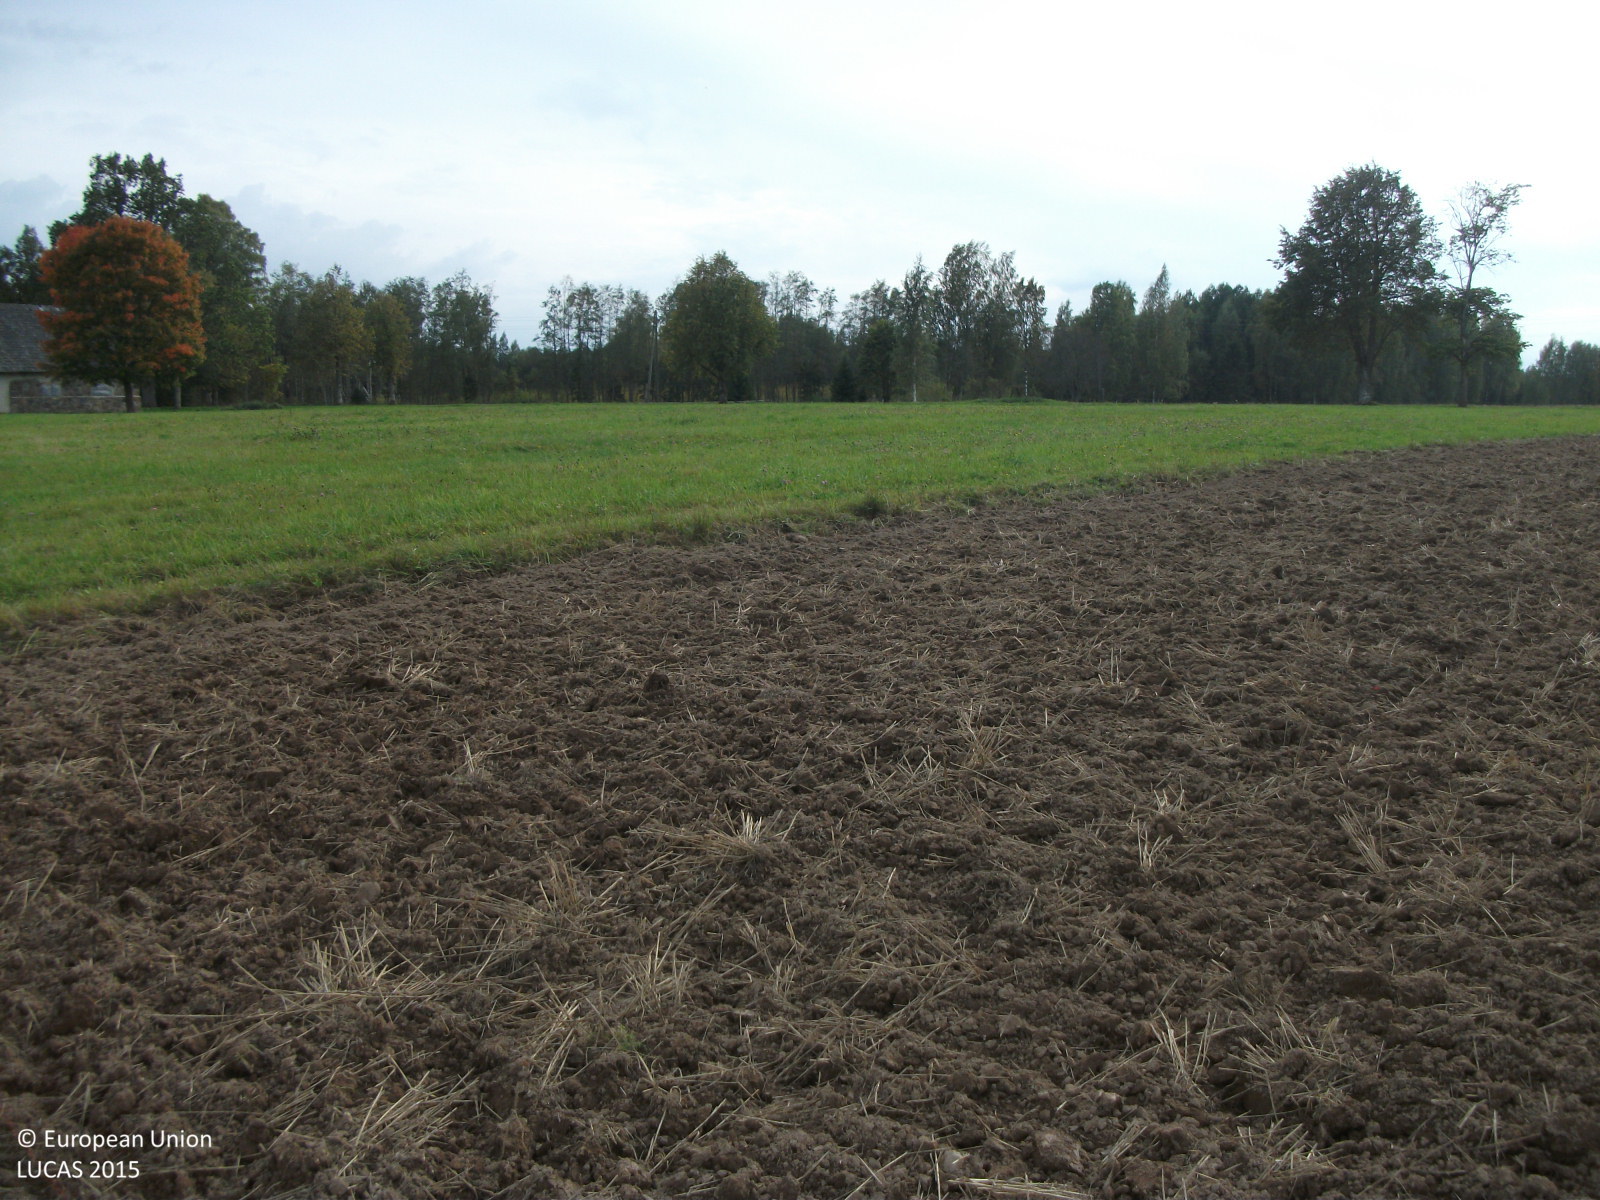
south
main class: Cropland
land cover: Common wheat
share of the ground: < 10 %
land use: Agriculture (excluding fallow land and kitchen gardens)
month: September
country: LV
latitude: 57.7562
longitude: 24.8354
